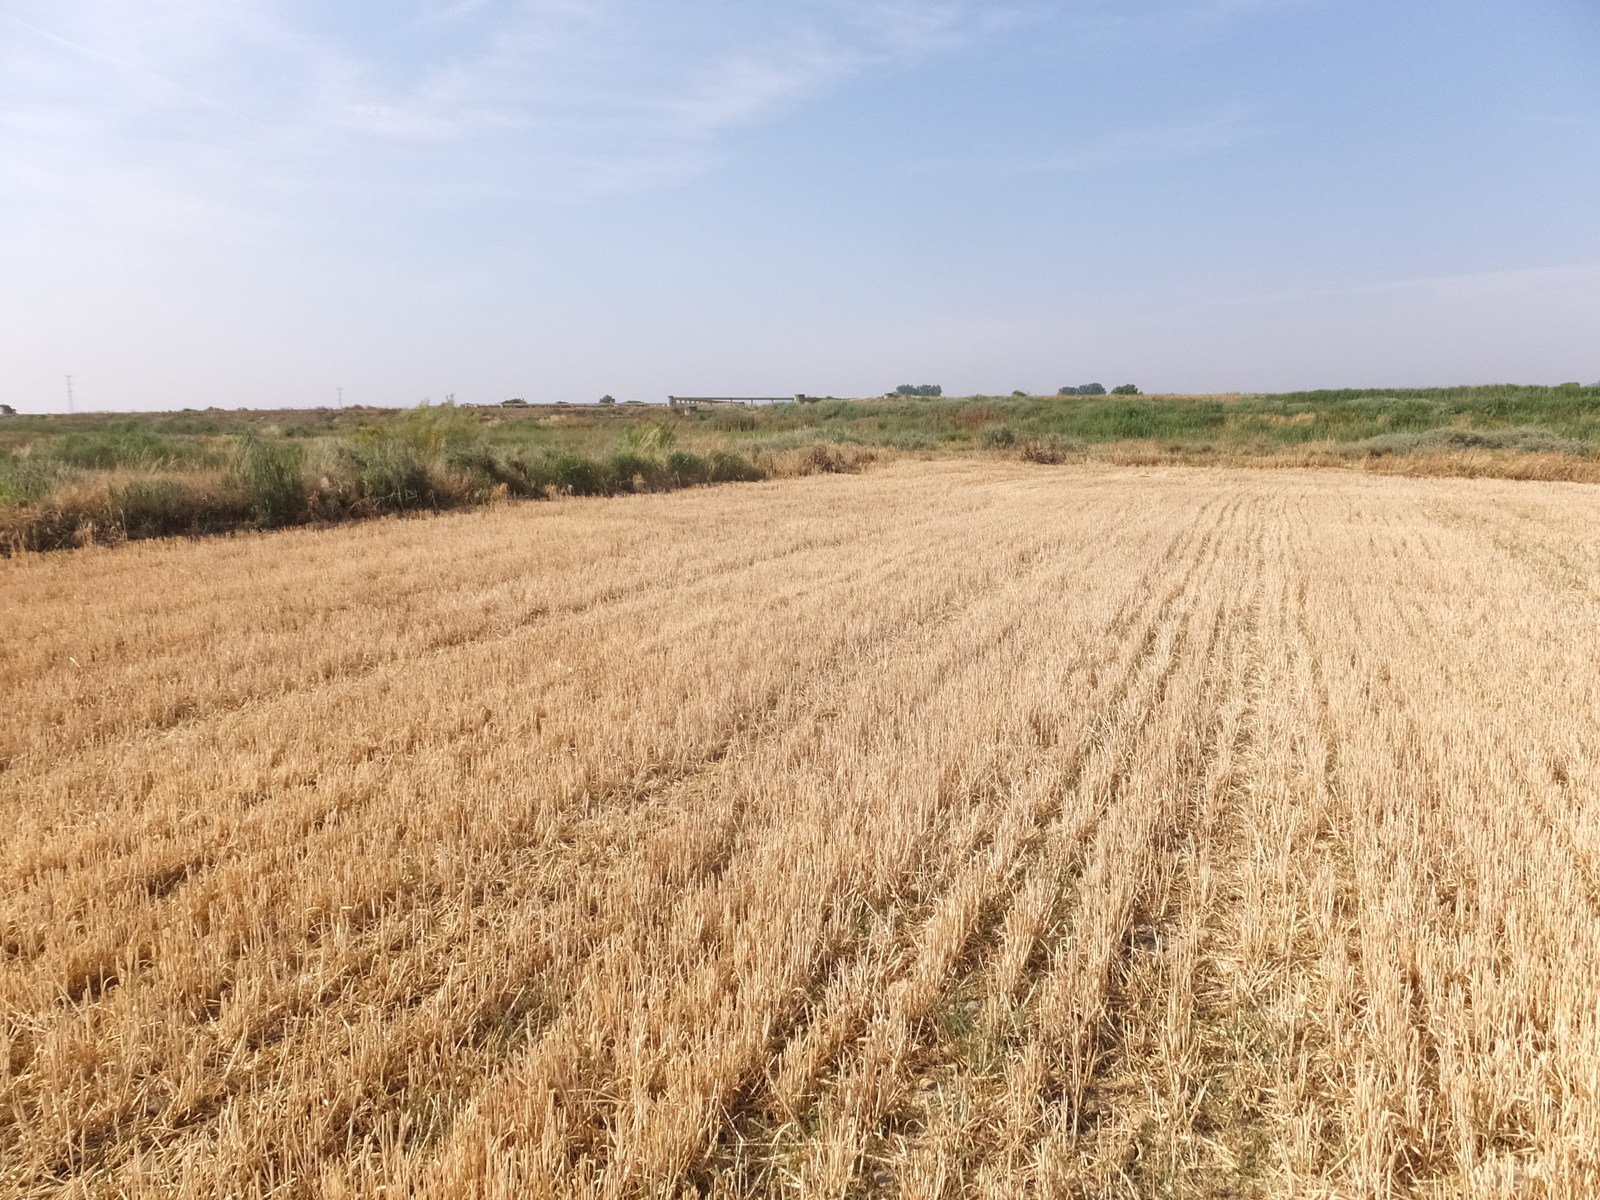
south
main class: Cropland
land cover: Barley
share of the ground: < 10 %
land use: Agriculture (excluding fallow land and kitchen gardens)
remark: Harvested field
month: June
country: ES
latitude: 41.7615
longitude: 0.0363
